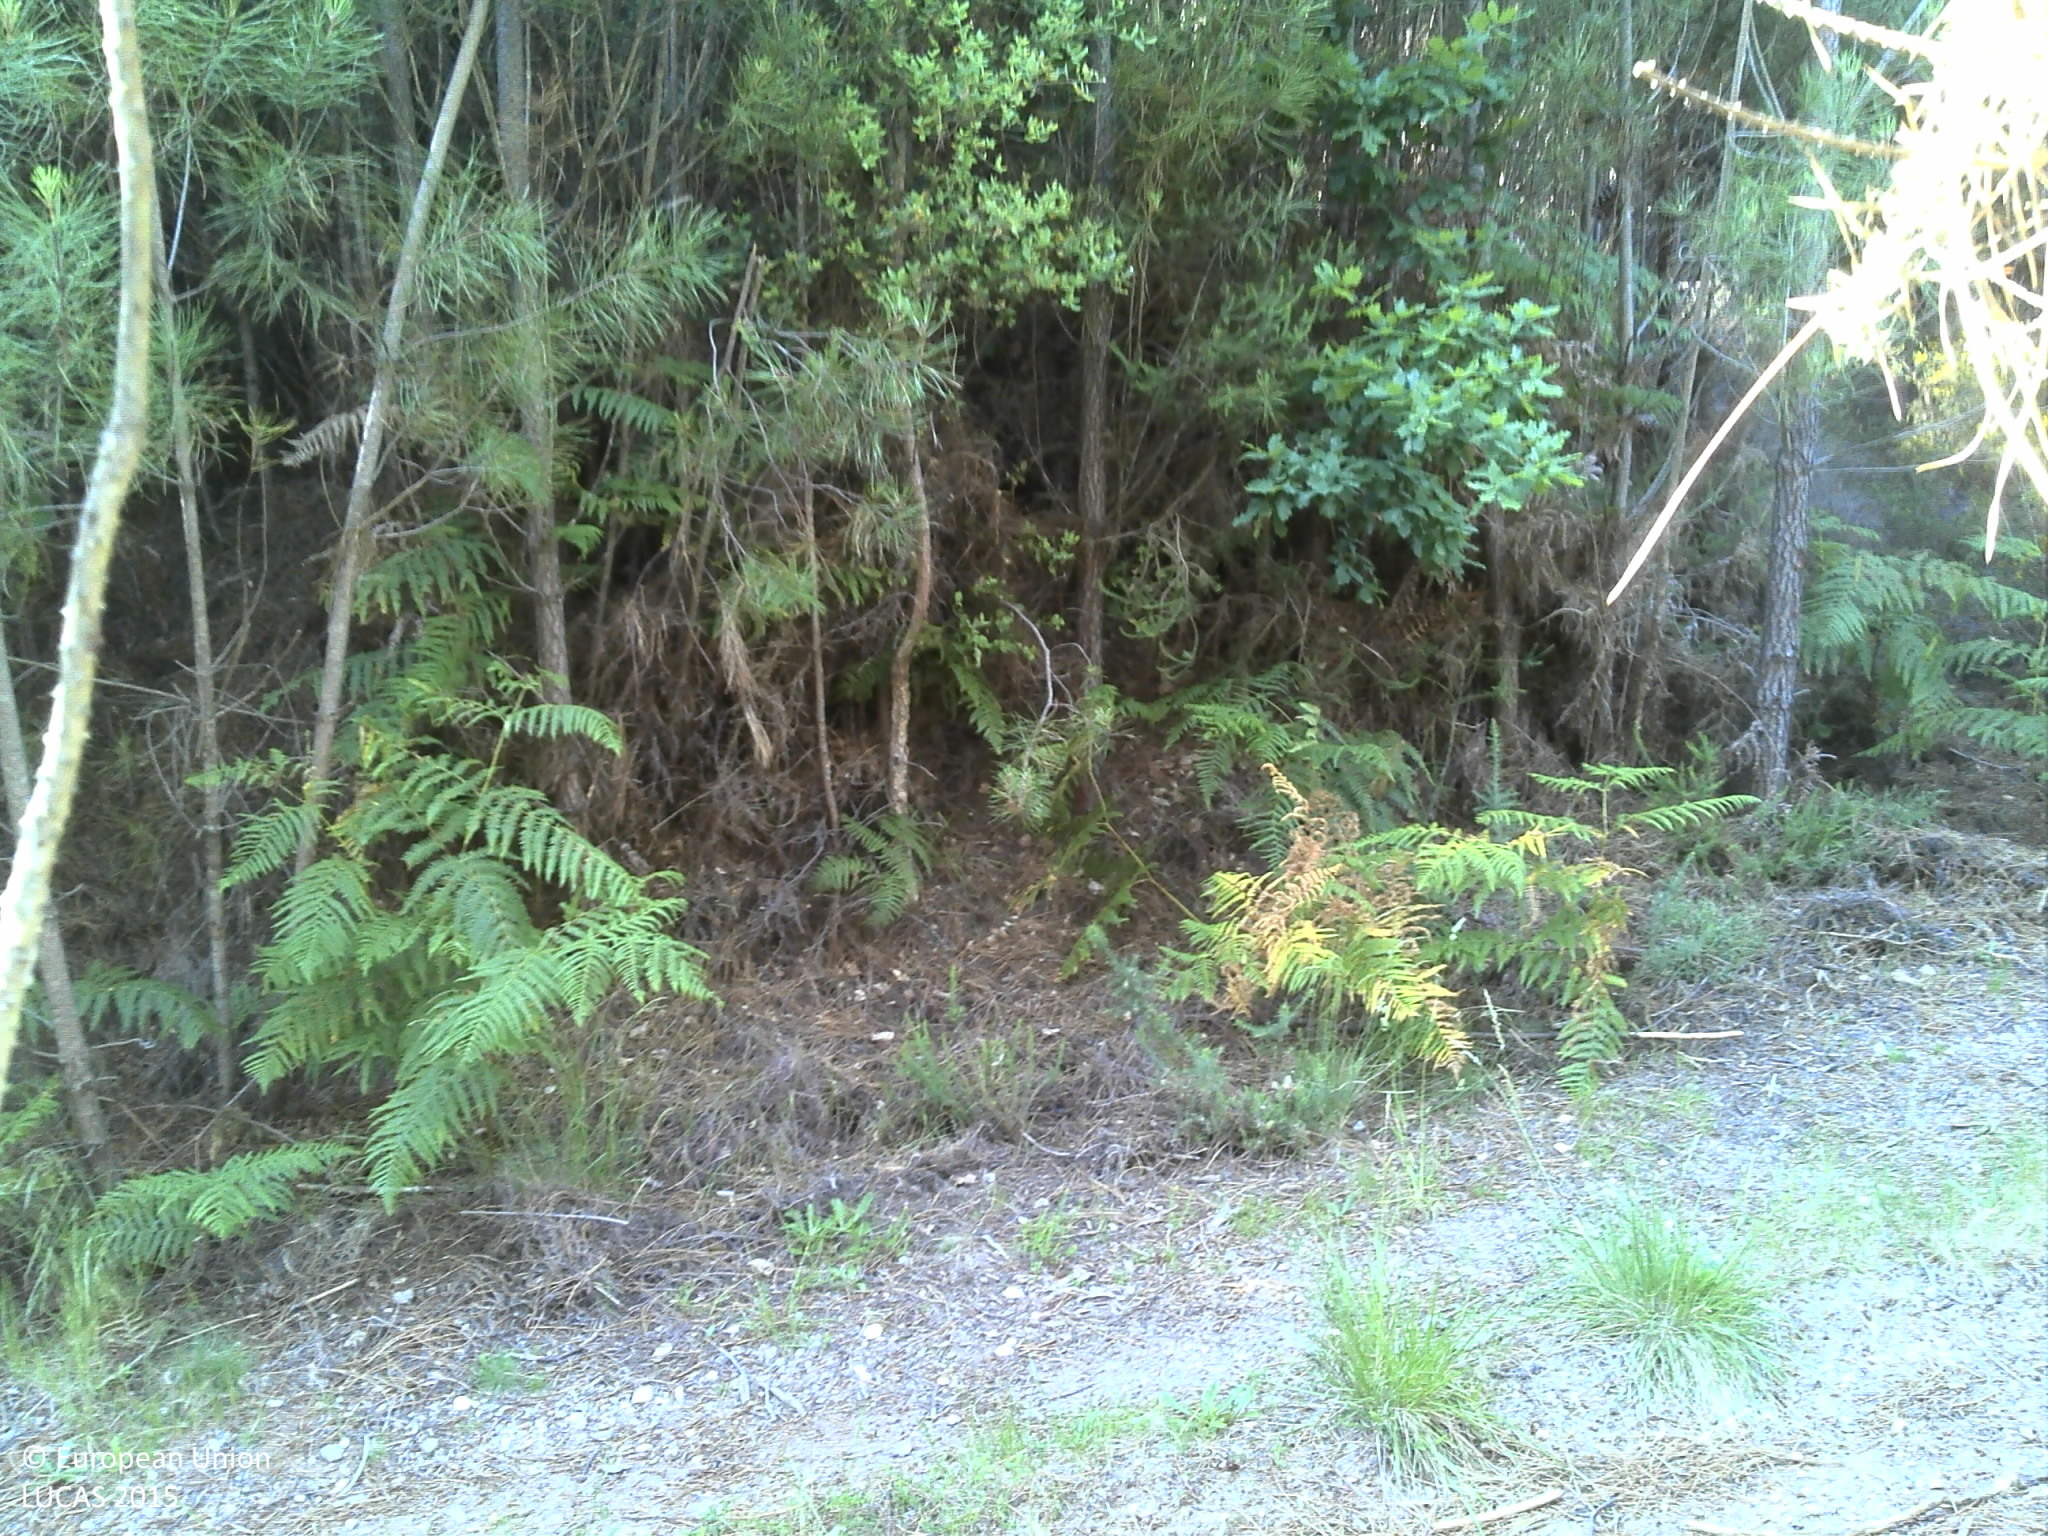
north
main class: Woodland
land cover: Pine dominated coniferous woodland
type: coniferous forest of the mediterranean region
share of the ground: 50 - 75 %
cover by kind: coniferous forest trees 75 %, shrubs 10 %, unconsolidated bare surface 10 %, herbaceous plants 5 %
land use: Forestry
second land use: Agriculture (excluding fallow land and kitchen gardens)
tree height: > 5 m
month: June
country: PT
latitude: 42.0559
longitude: -8.3202
